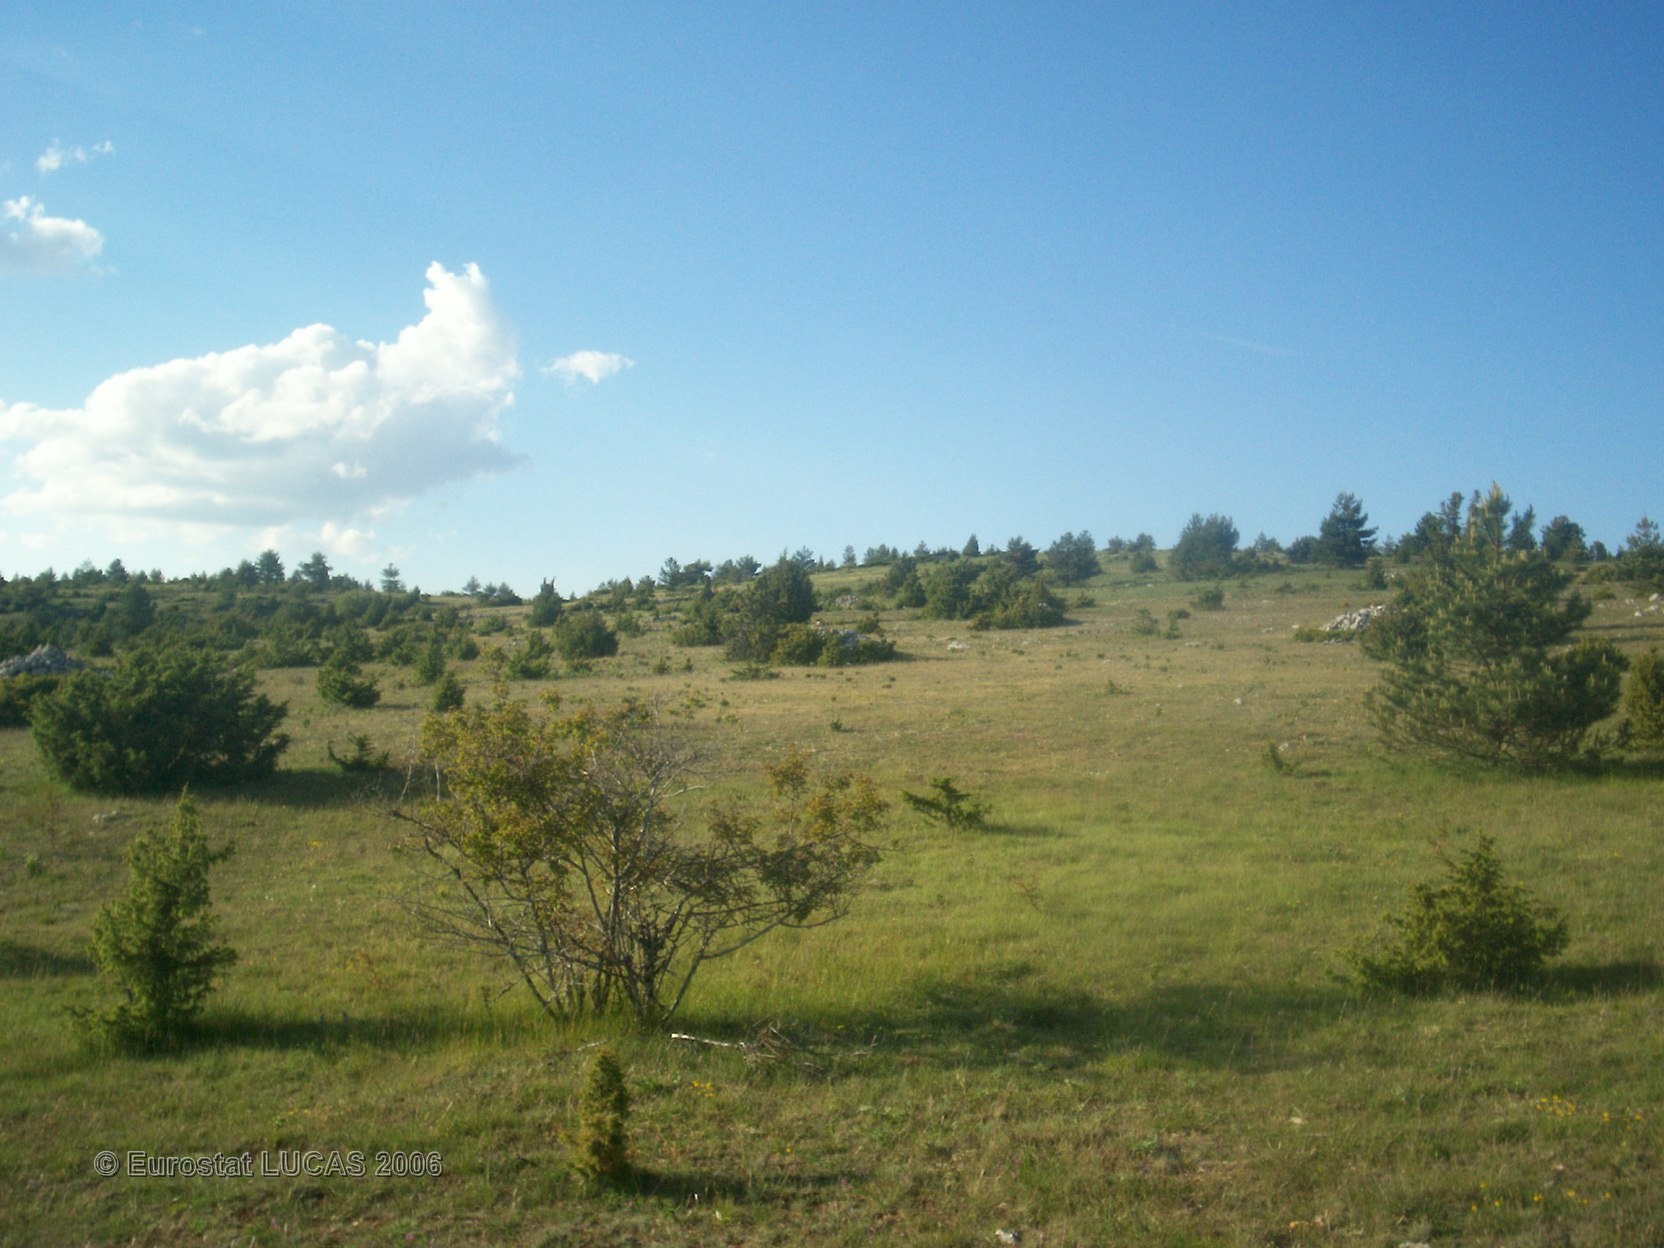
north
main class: Grassland
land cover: Grassland without tree/shrub cover
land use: Agriculture (excluding fallow land and kitchen gardens)
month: June
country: FR
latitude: 44.3243
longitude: 3.4477
